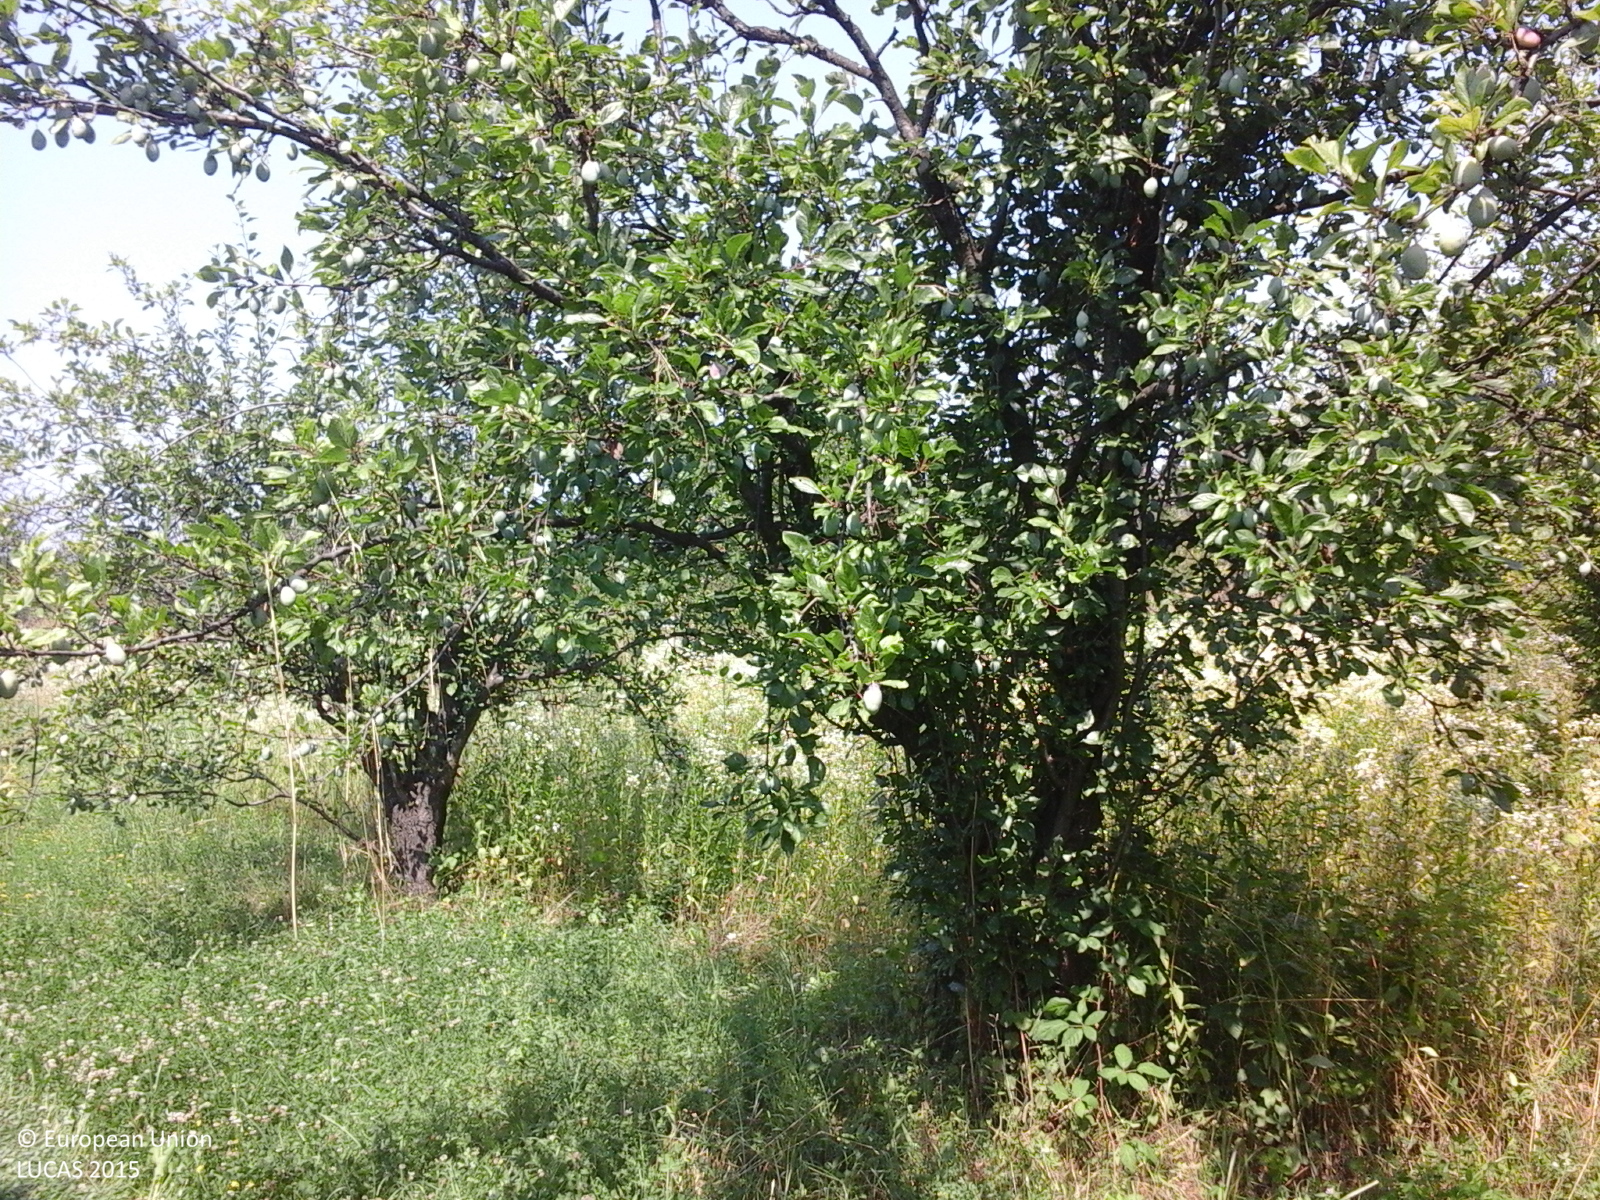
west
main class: Cropland
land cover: Other fruit trees and berries
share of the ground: > 75 %
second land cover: Grassland without tree/shrub cover
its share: 25 - 50 %
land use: Agriculture (excluding fallow land and kitchen gardens)
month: July
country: RO
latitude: 44.8333
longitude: 25.4629
